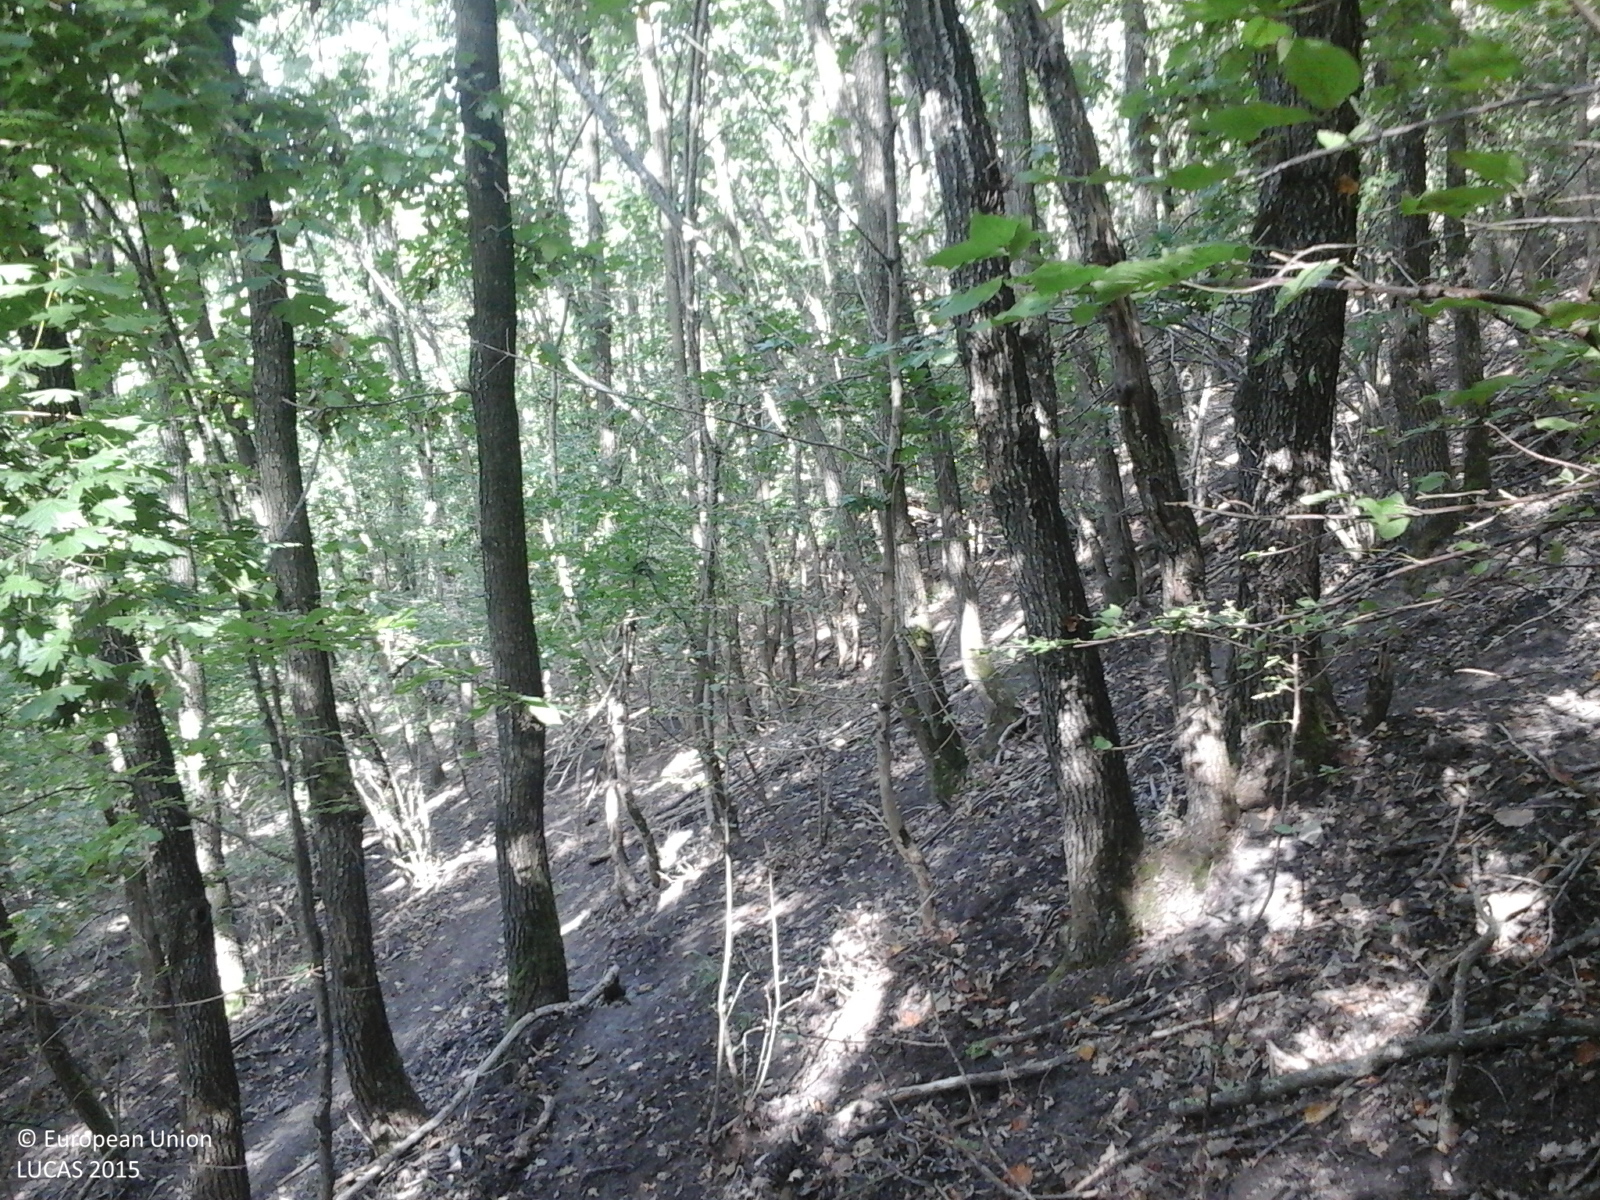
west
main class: Woodland
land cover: Broadleaved woodland
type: acidophilous oak and oak-birch forest
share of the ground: > 75 %
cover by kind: broadleaved forest trees 100 %
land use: Forestry
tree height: > 5 m
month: September
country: RO
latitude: 47.0883
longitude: 23.7090
